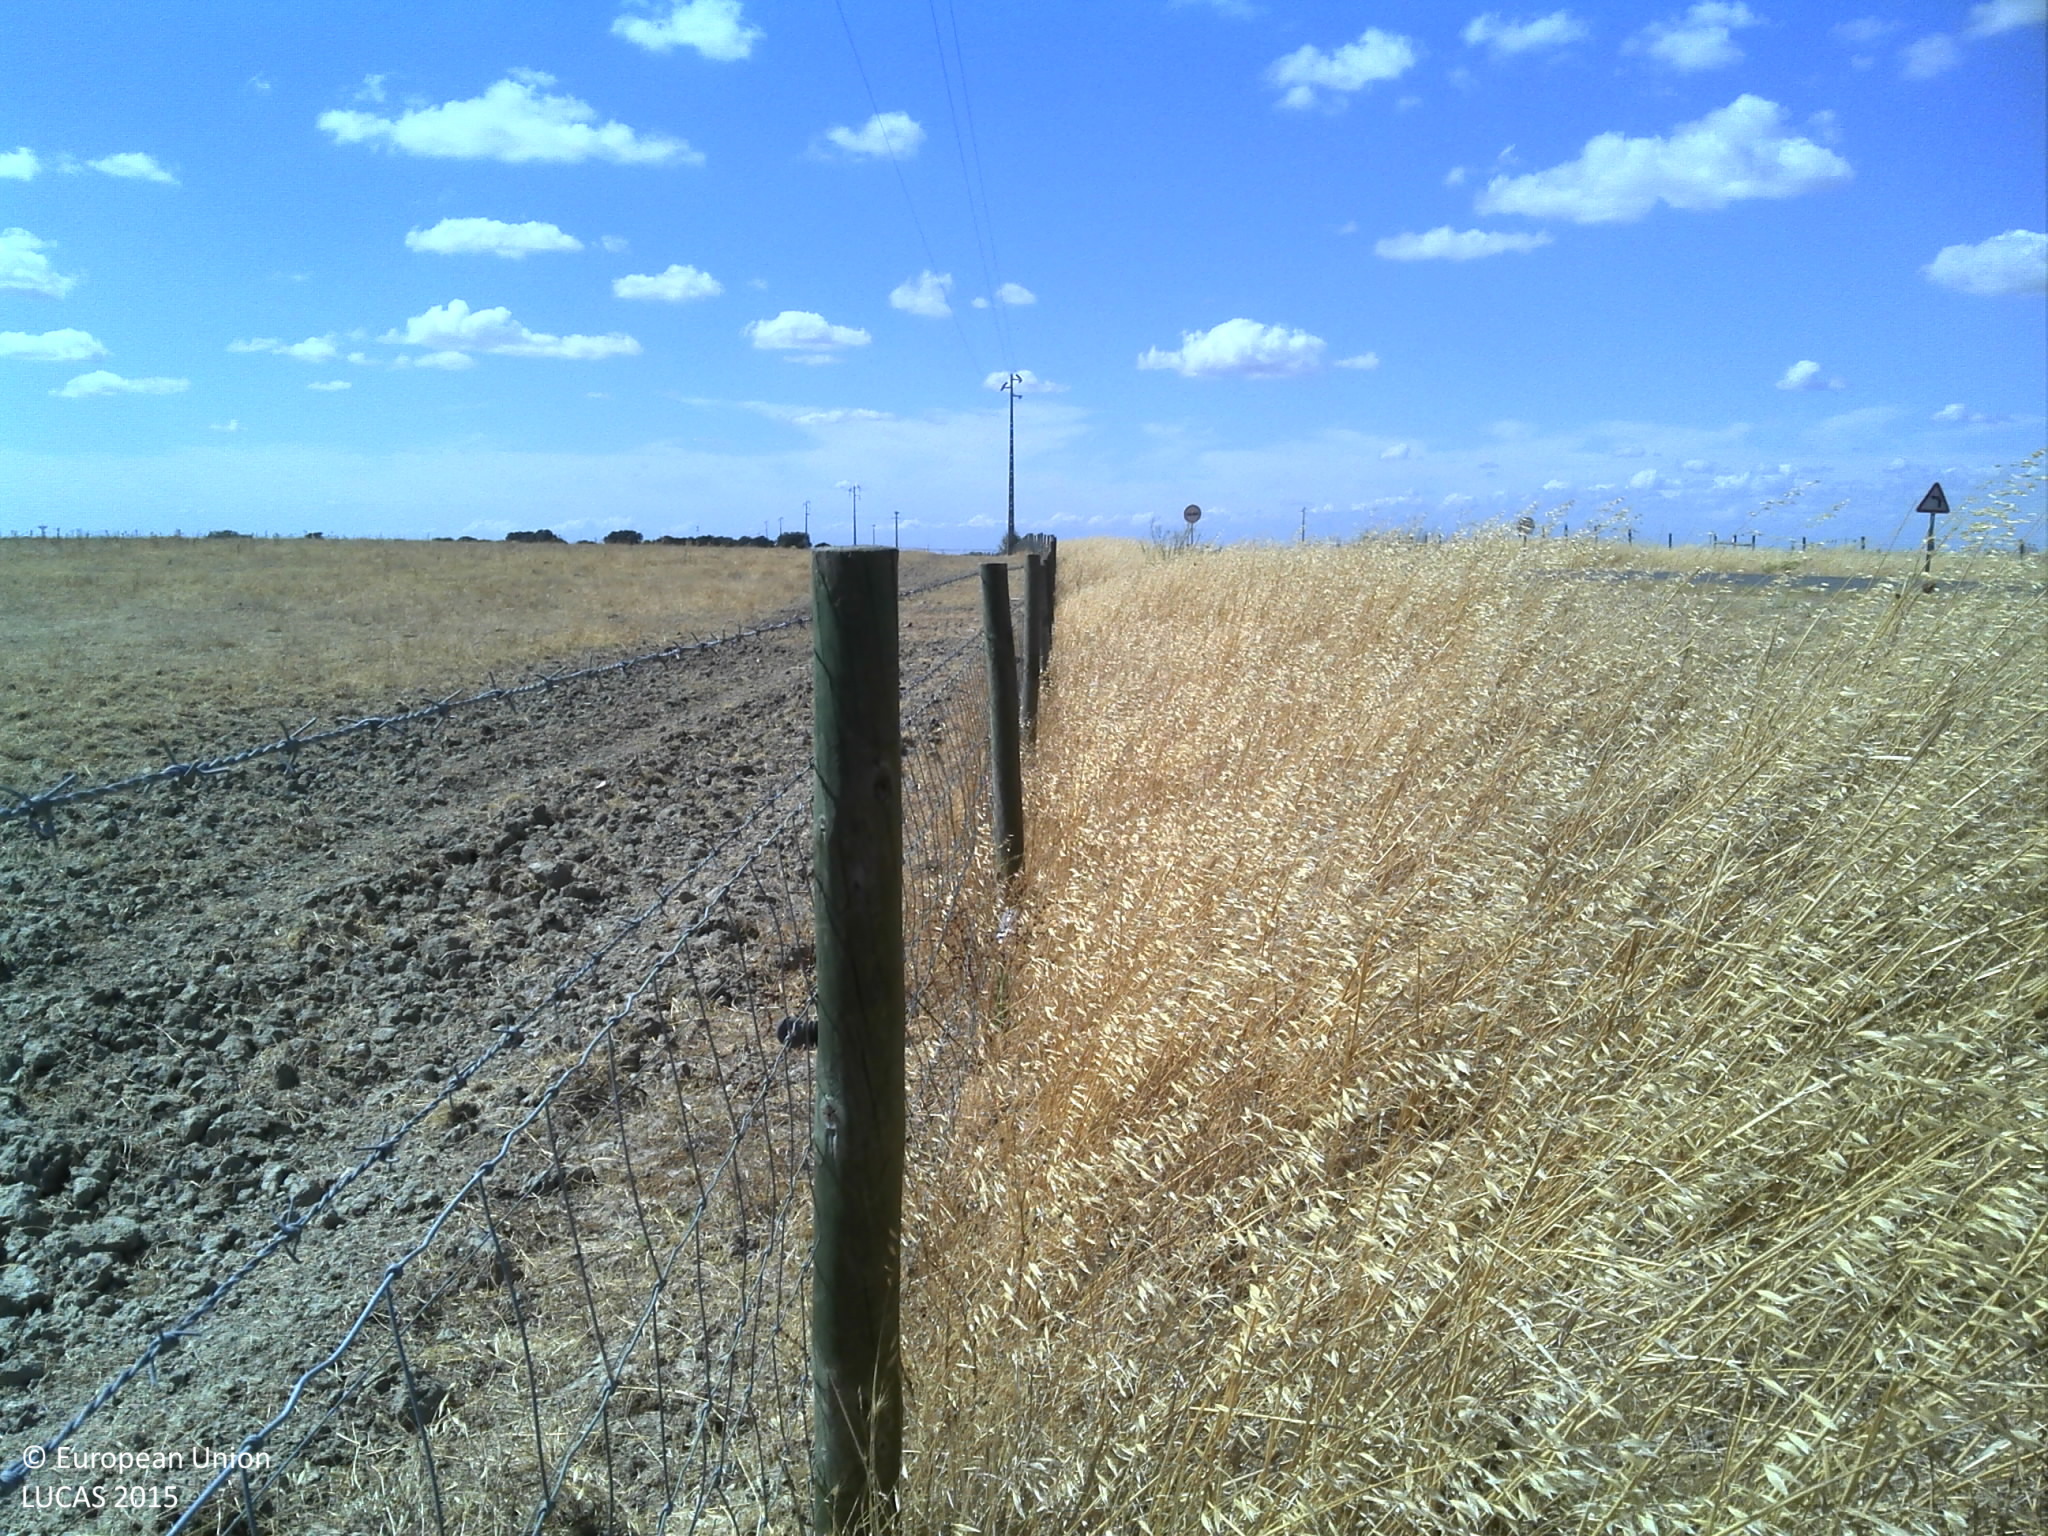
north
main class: Grassland
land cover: Grassland without tree/shrub cover
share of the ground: 50 - 75 %
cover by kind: herbaceous plants 75 %, unconsolidated bare surface 25 %
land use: Agriculture (excluding fallow land and kitchen gardens)
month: July
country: PT
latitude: 38.0537
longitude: -7.8870
